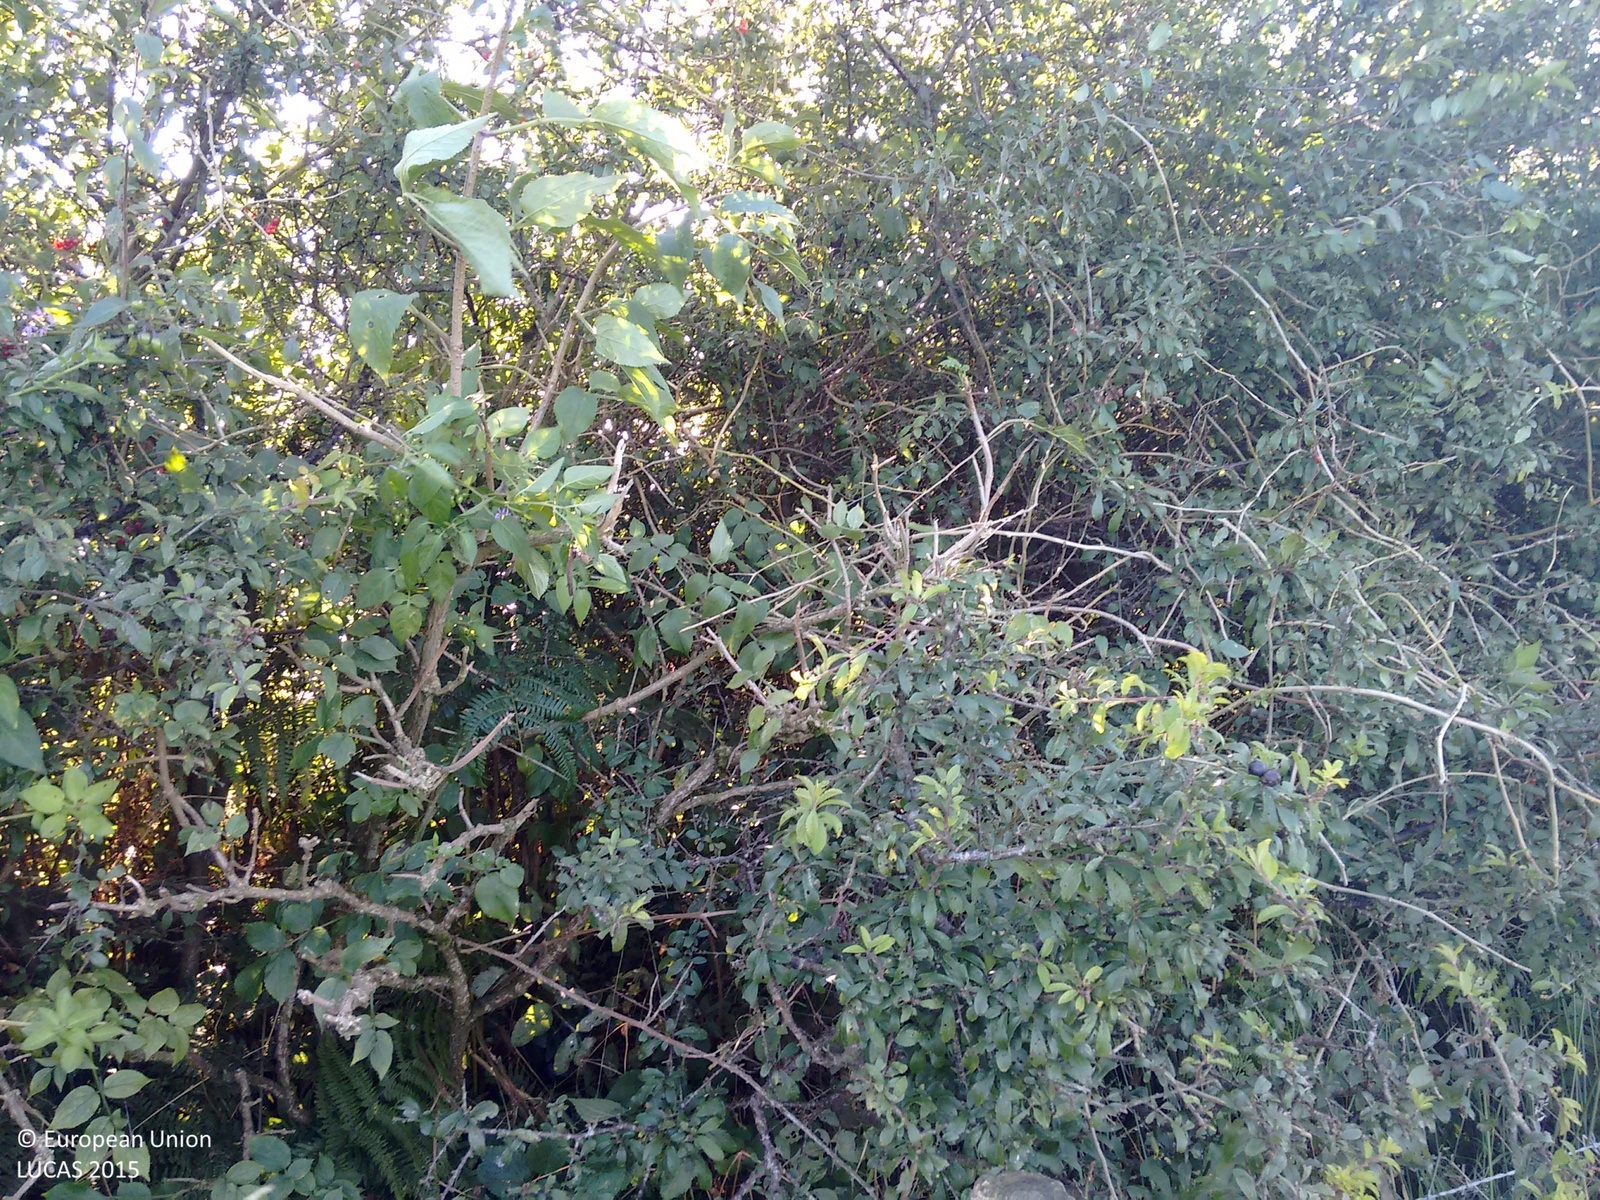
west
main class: Grassland
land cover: Grassland without tree/shrub cover
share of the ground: > 75 %
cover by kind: herbaceous plants 100 %
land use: Agriculture (excluding fallow land and kitchen gardens)
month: September
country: GB
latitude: 50.8879
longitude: -4.4180
